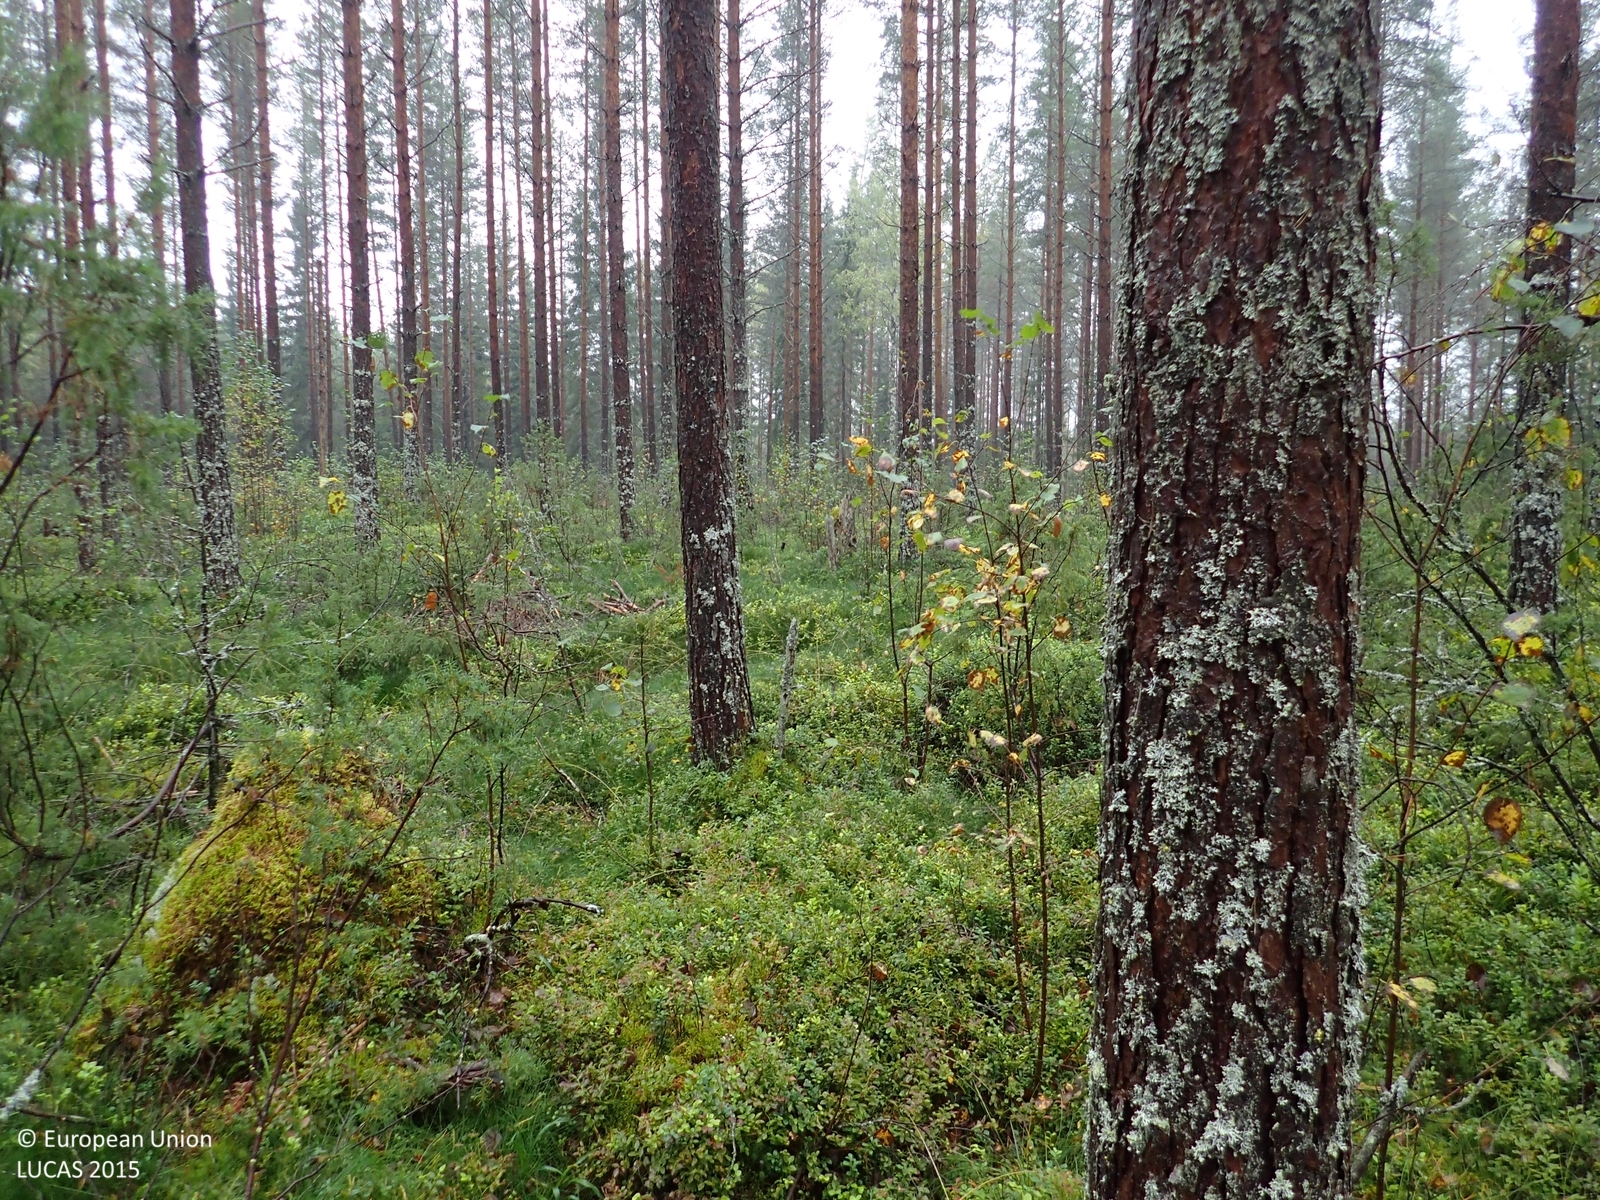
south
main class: Woodland
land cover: Other coniferous woodland
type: boreal forest
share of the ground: > 75 %
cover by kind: coniferous forest trees 70 %, shrubs 20 %, broadleaved forest trees 5 %, herbaceous plants 5 %
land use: Forestry
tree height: > 5 m
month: September
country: FI
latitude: 63.2464
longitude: 25.4549
